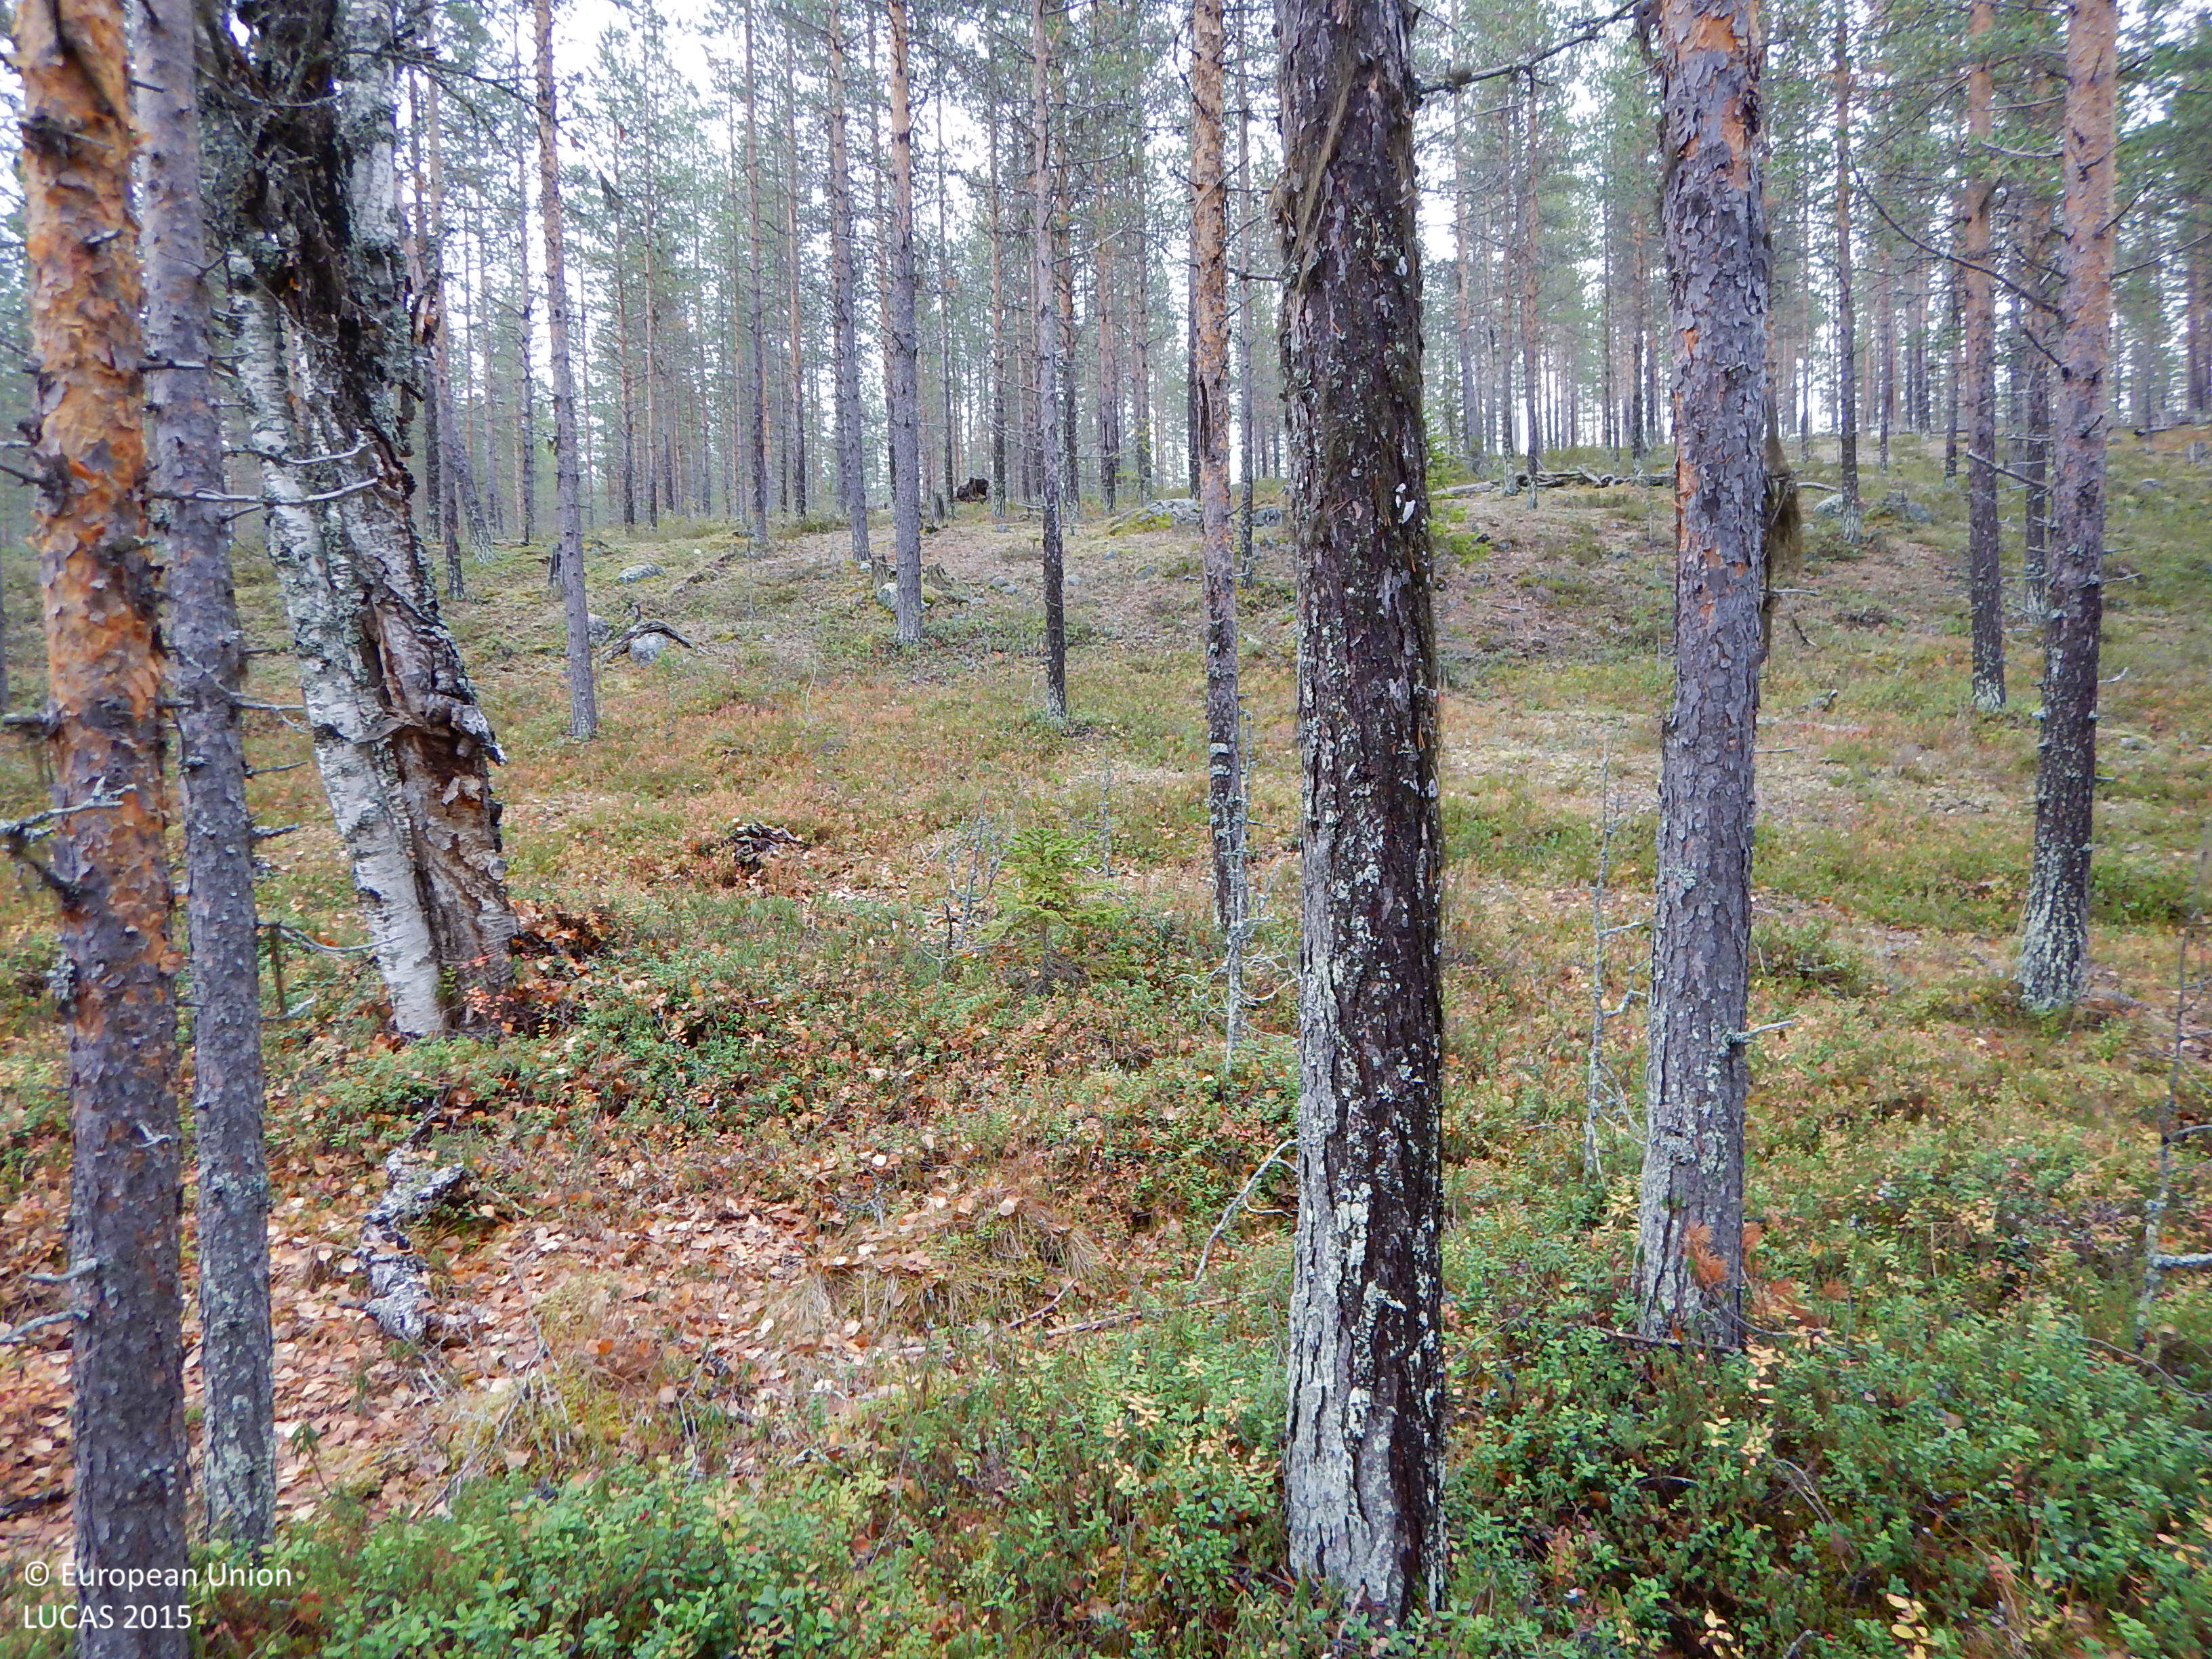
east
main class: Woodland
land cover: Pine dominated coniferous woodland
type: boreal forest
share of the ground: 50 - 75 %
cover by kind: coniferous forest trees 55 %, shrubs 20 %, lichens and mosses 20 %, herbaceous plants 5 %
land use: Forestry
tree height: > 5 m
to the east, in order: Pine dominated coniferous woodland; Tracks; Pine dominated coniferous woodland; Tracks; Pine dominated coniferous woodland; Tracks; Pine dominated coniferous woodland; Tracks; Pine dominated coniferous woodland
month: September
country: SE
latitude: 65.0945
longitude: 19.2228
